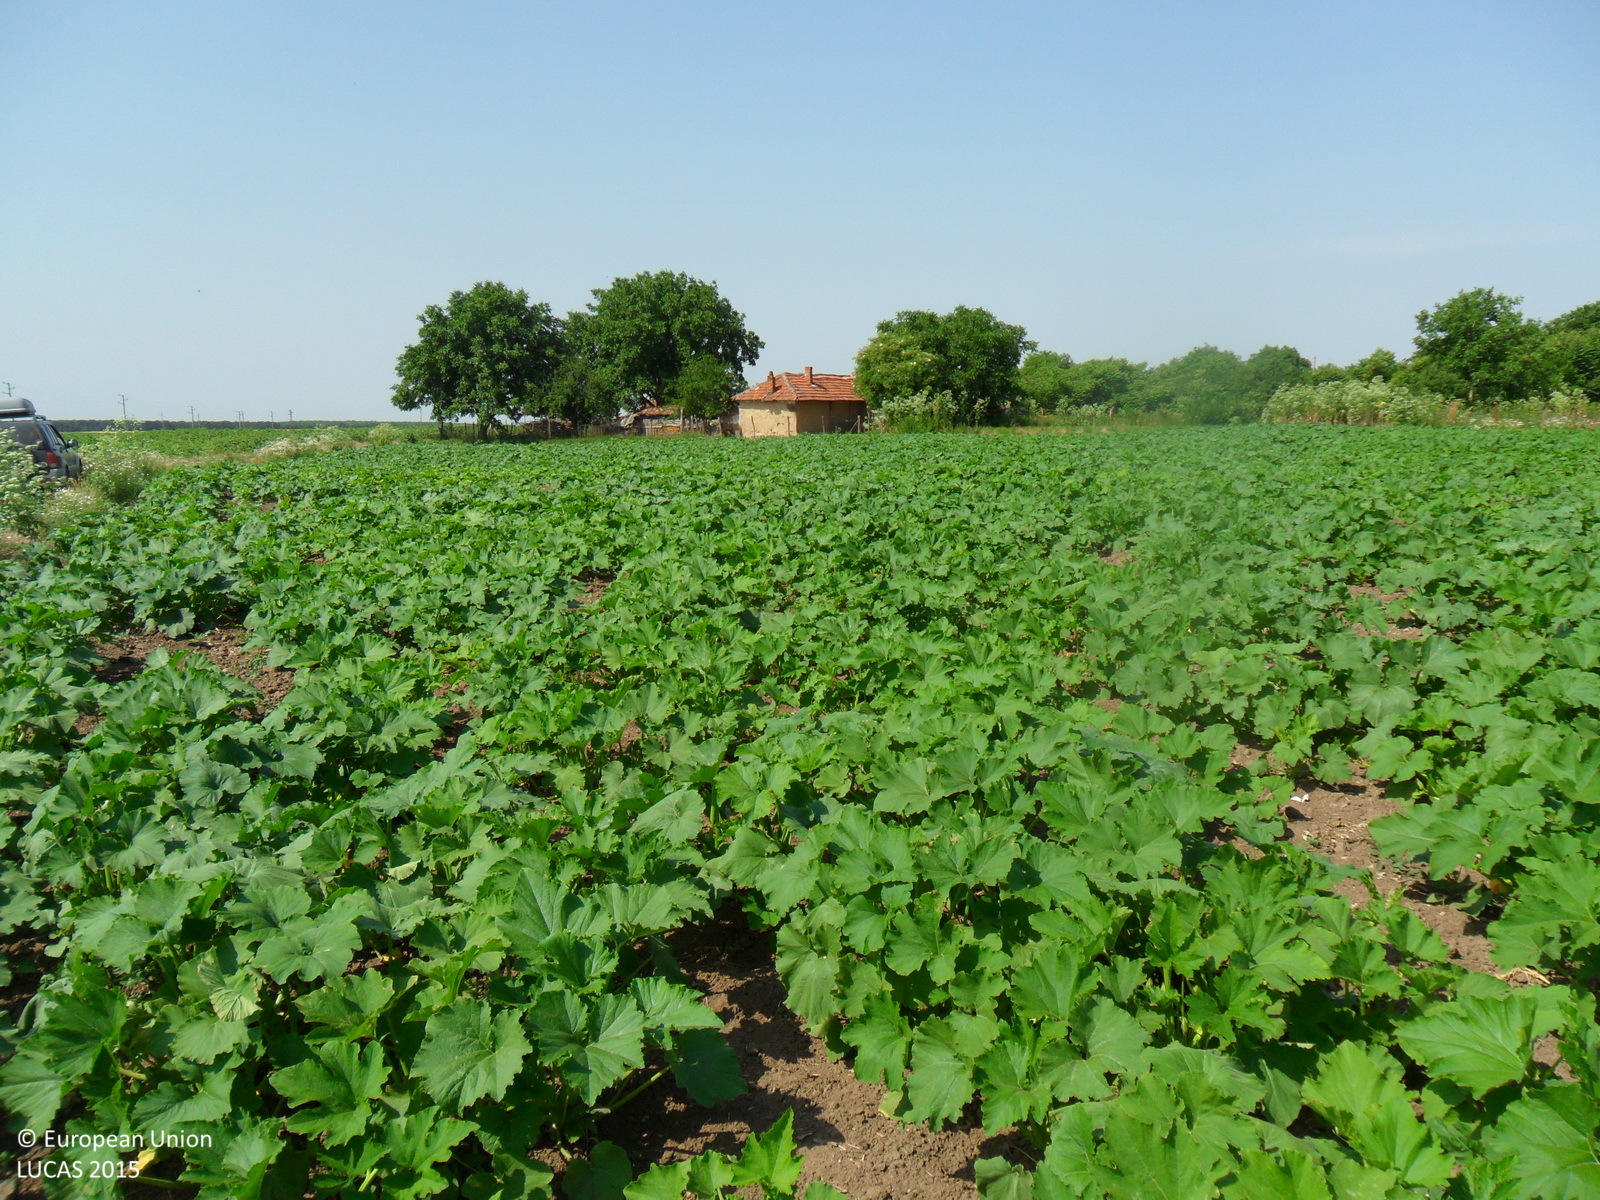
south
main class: Cropland
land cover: Other fresh vegetables
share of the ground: 50 - 75 %
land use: Agriculture (excluding fallow land and kitchen gardens)
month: June
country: BG
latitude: 43.6661
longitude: 26.9214
